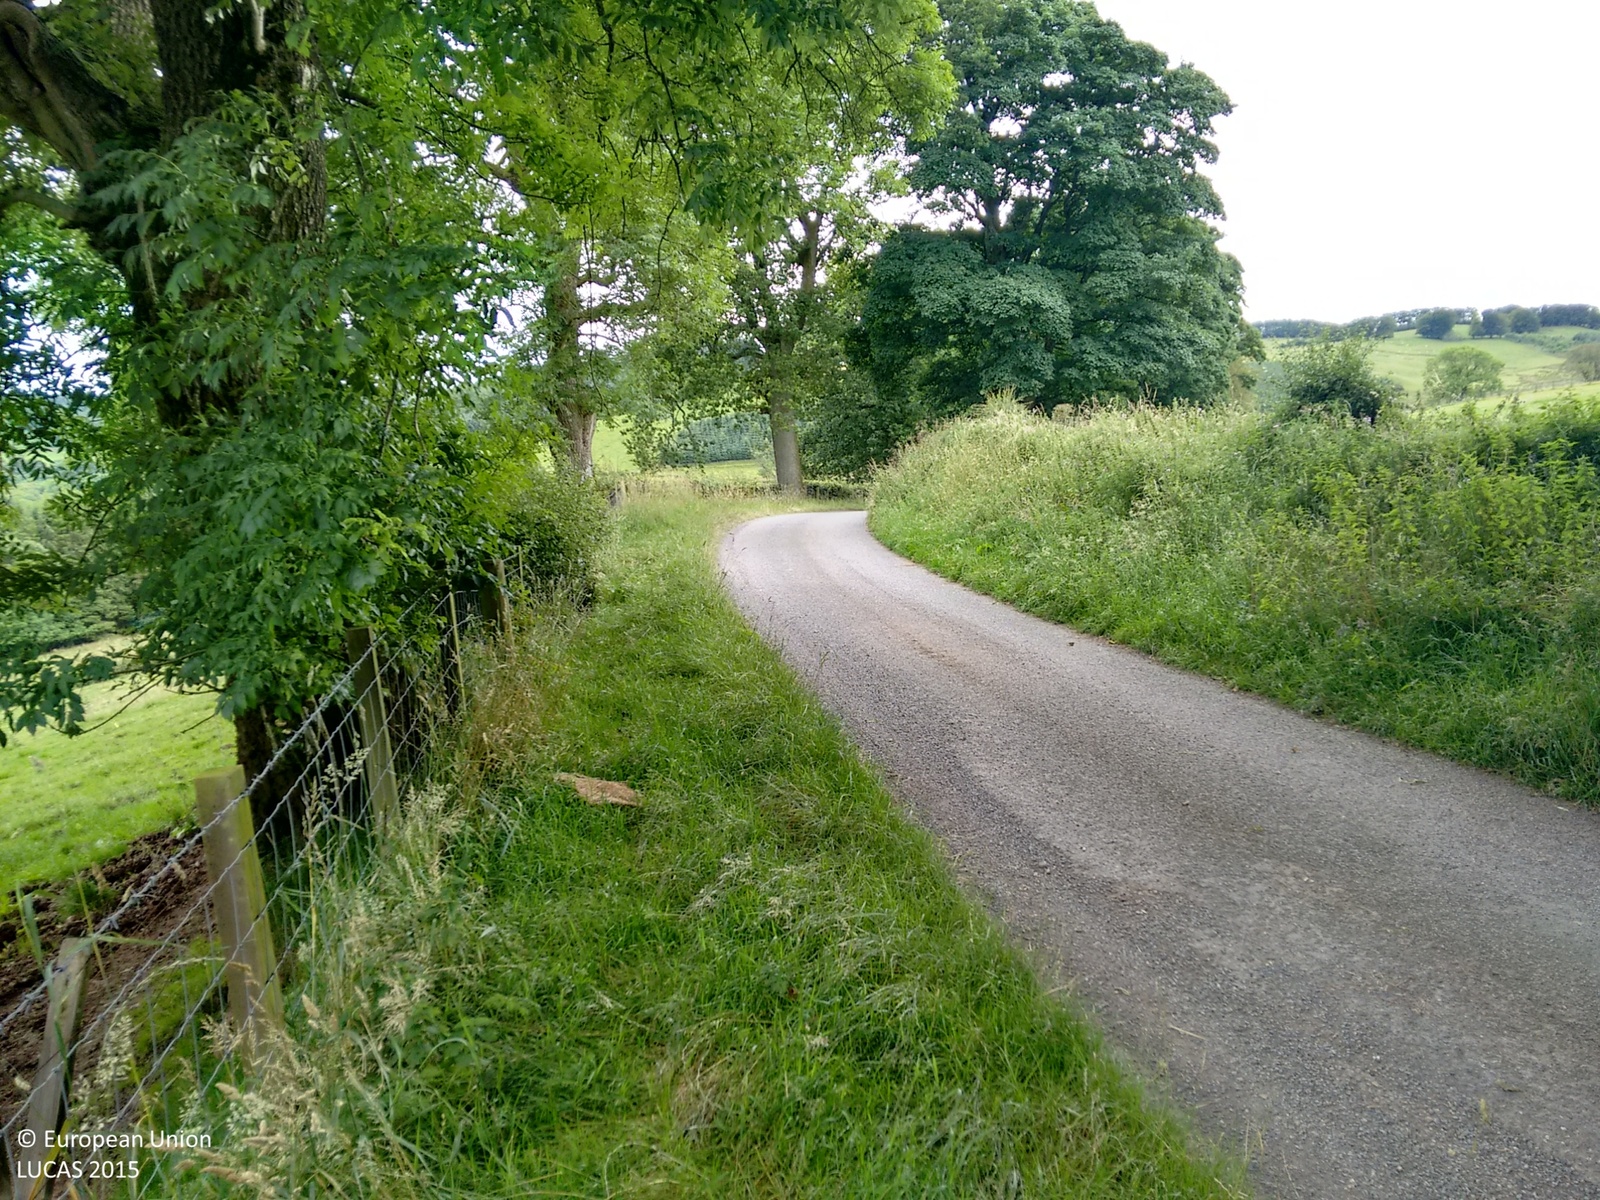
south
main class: Grassland
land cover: Grassland without tree/shrub cover
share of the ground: > 75 %
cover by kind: herbaceous plants 100 %
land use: Agriculture (excluding fallow land and kitchen gardens)
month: August
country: GB
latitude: 55.1939
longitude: -3.3512
